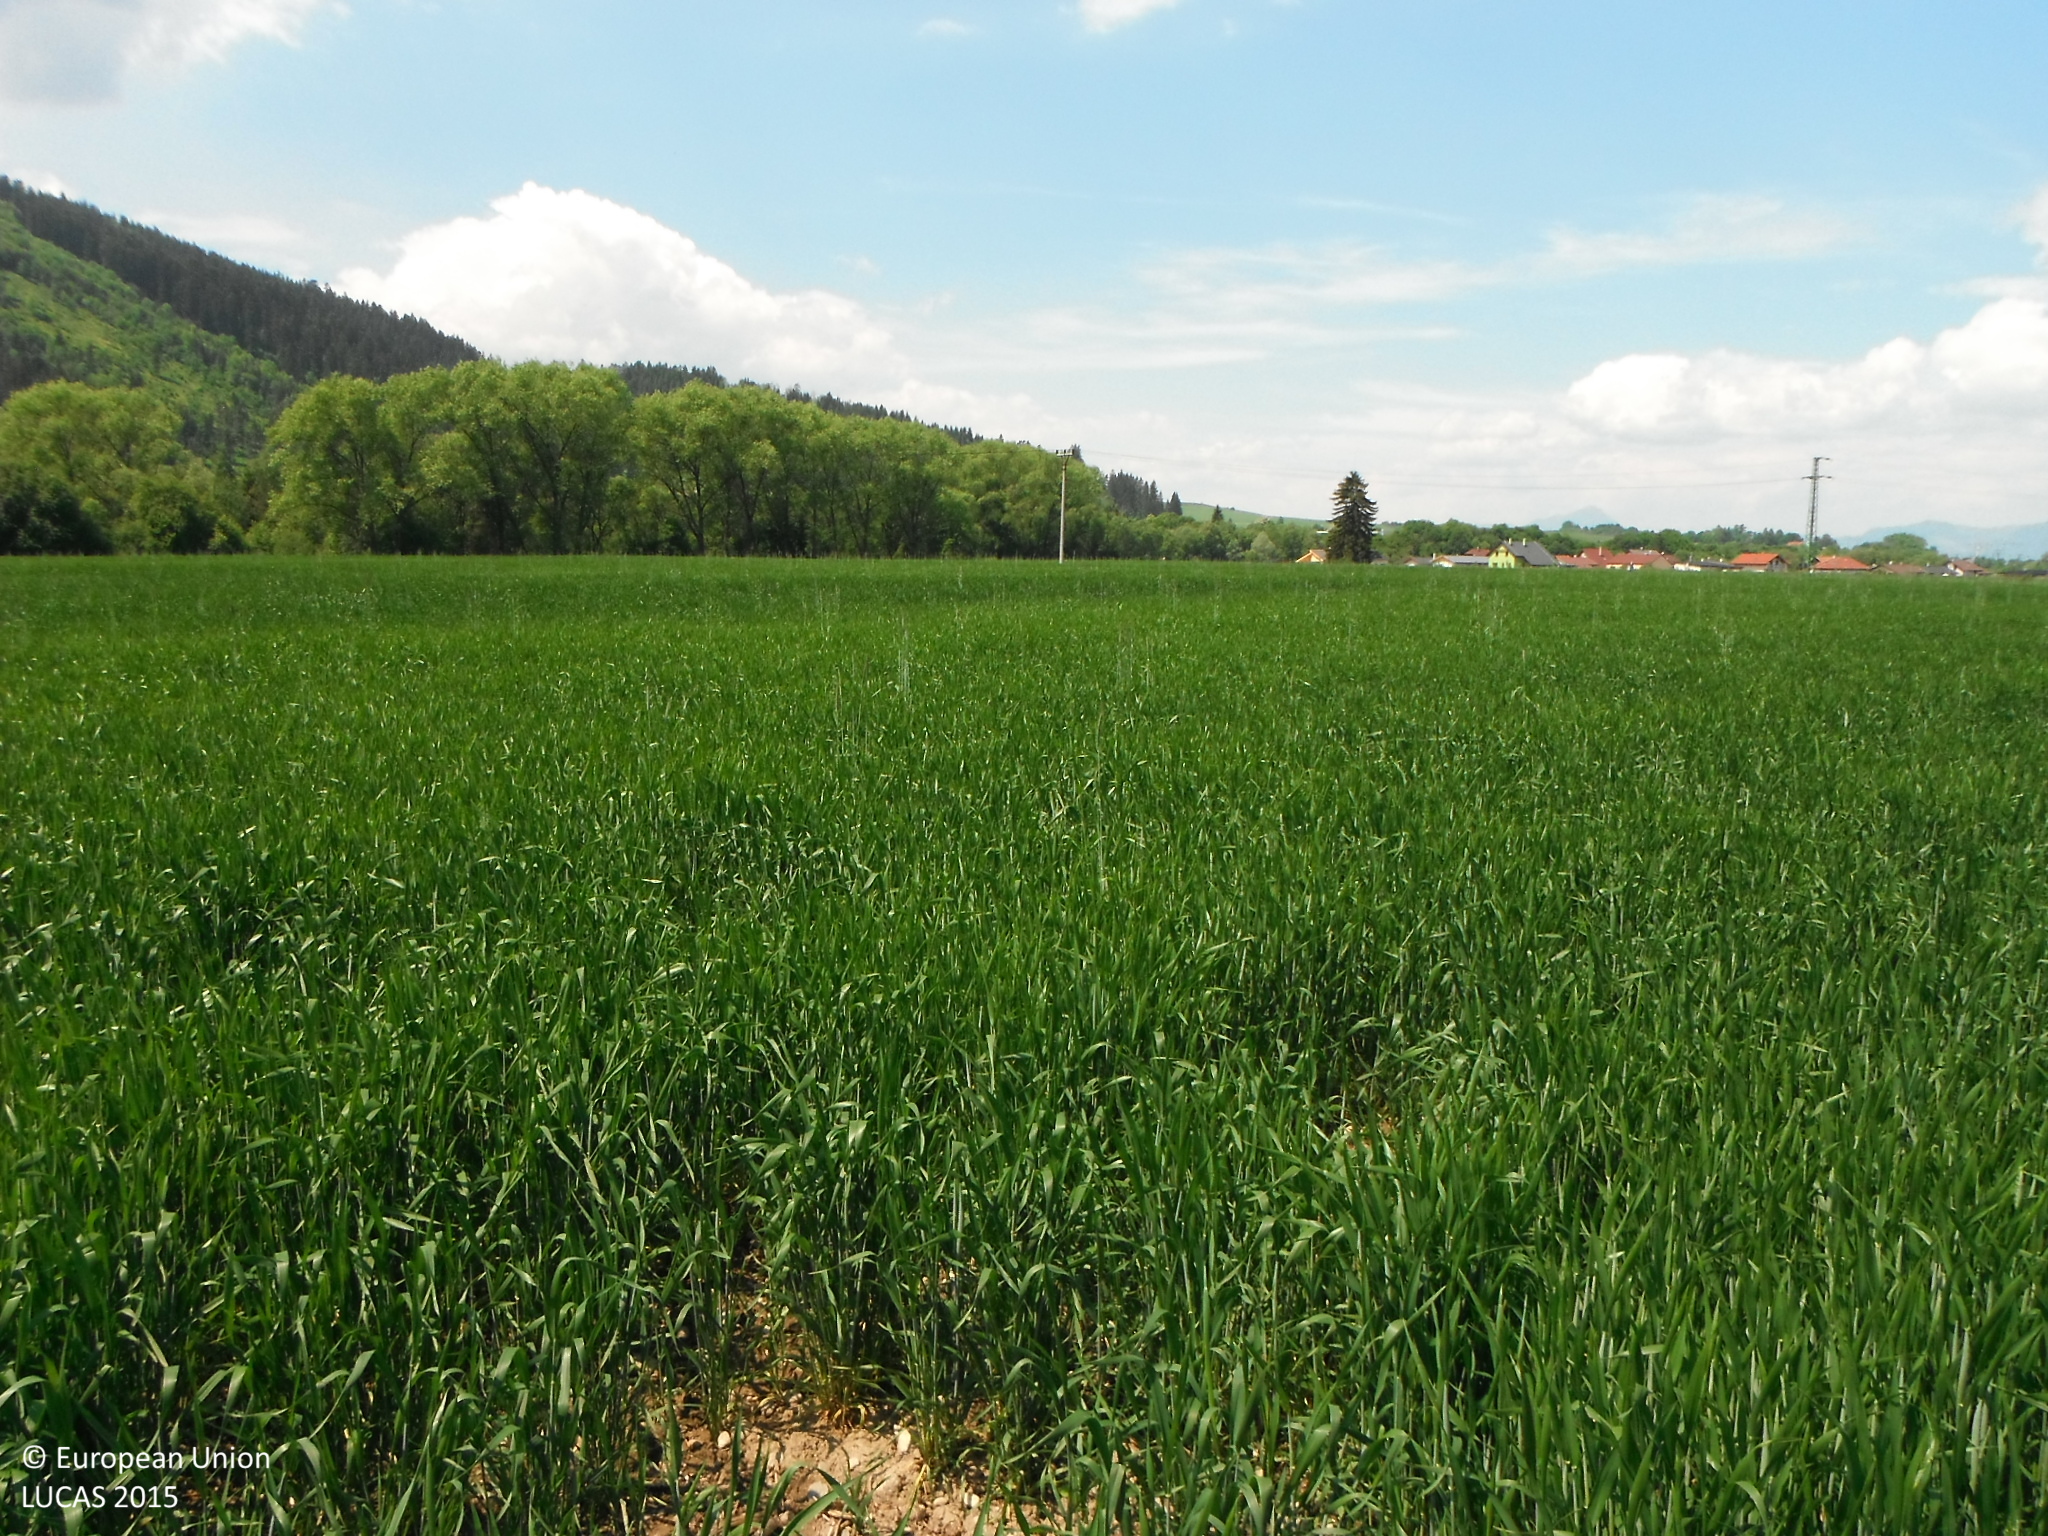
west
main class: Cropland
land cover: Common wheat
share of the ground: > 75 %
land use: Agriculture (excluding fallow land and kitchen gardens)
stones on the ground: > 50 %
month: June
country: SK
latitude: 49.0451
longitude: 19.7005
